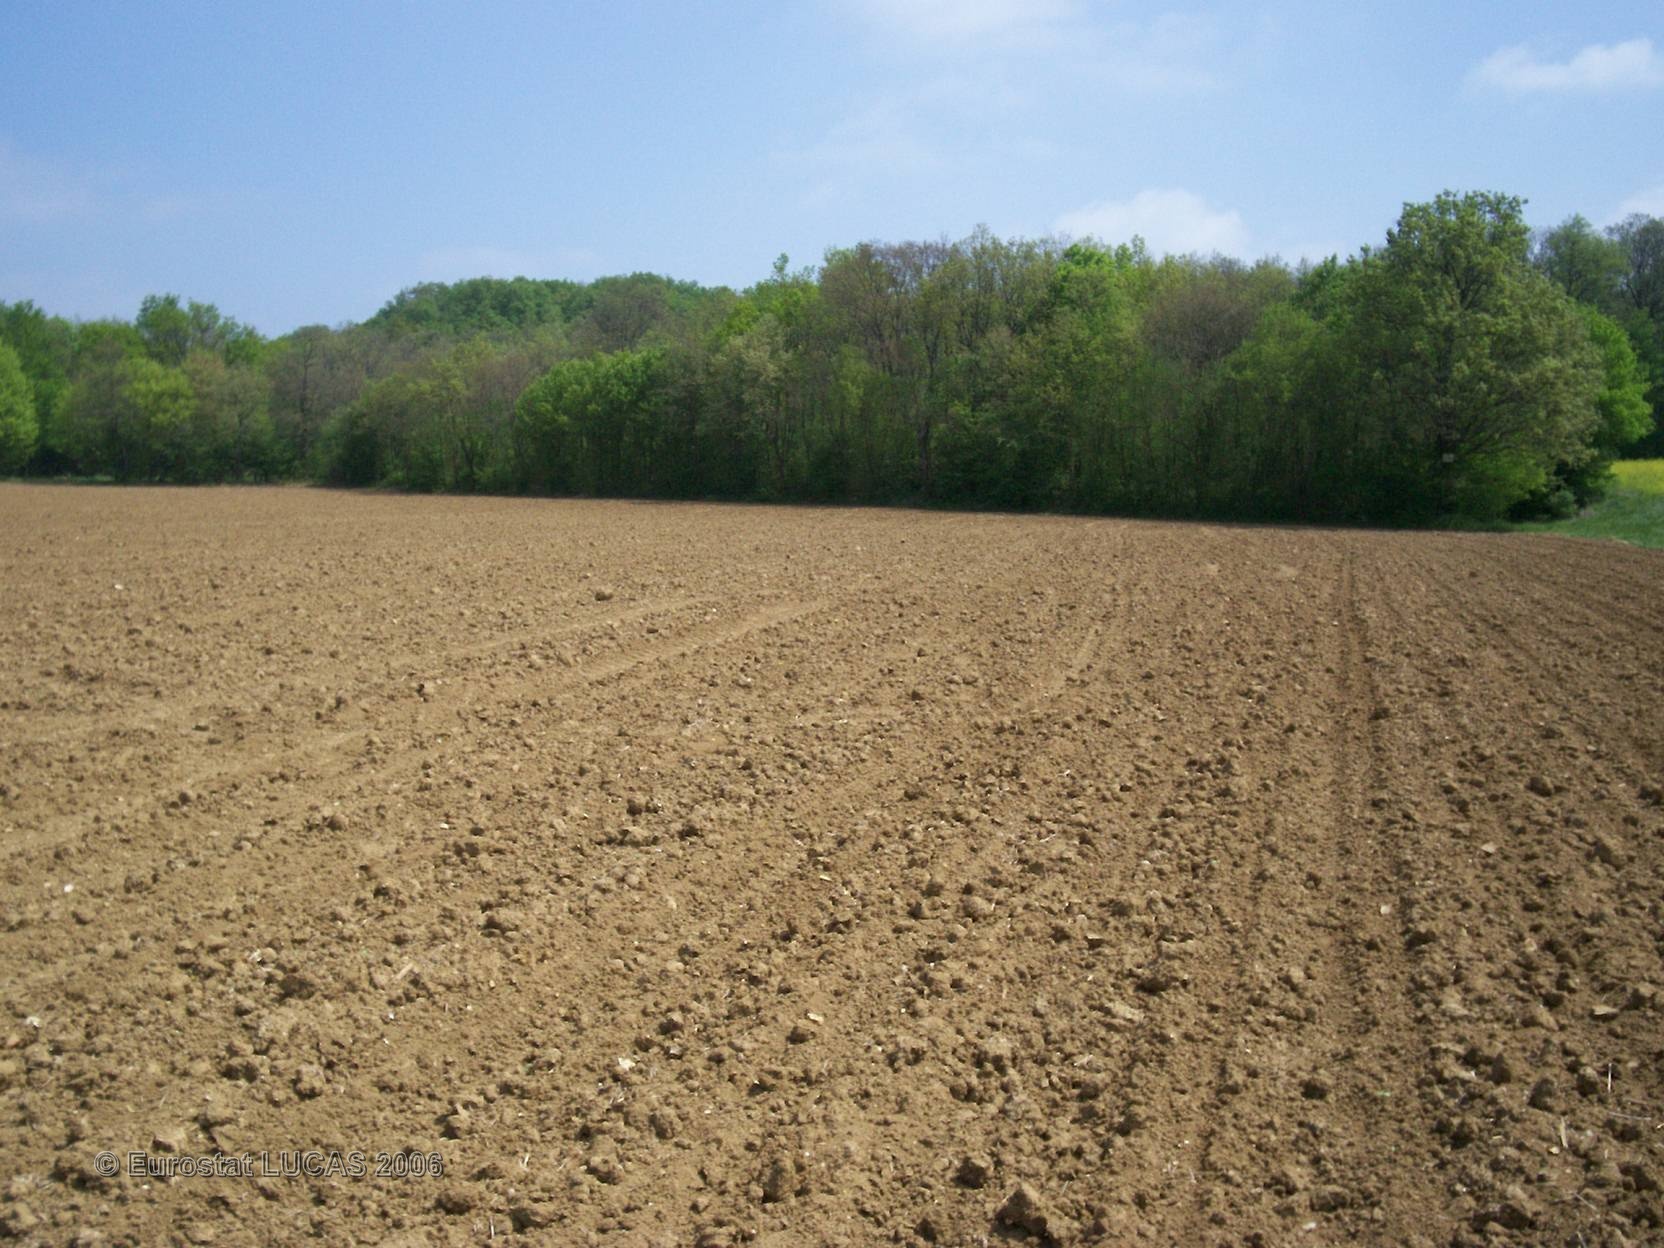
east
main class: Cropland
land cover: Sunflower
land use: Agriculture (excluding fallow land and kitchen gardens)
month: April
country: FR
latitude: 44.2465
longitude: 0.7660
